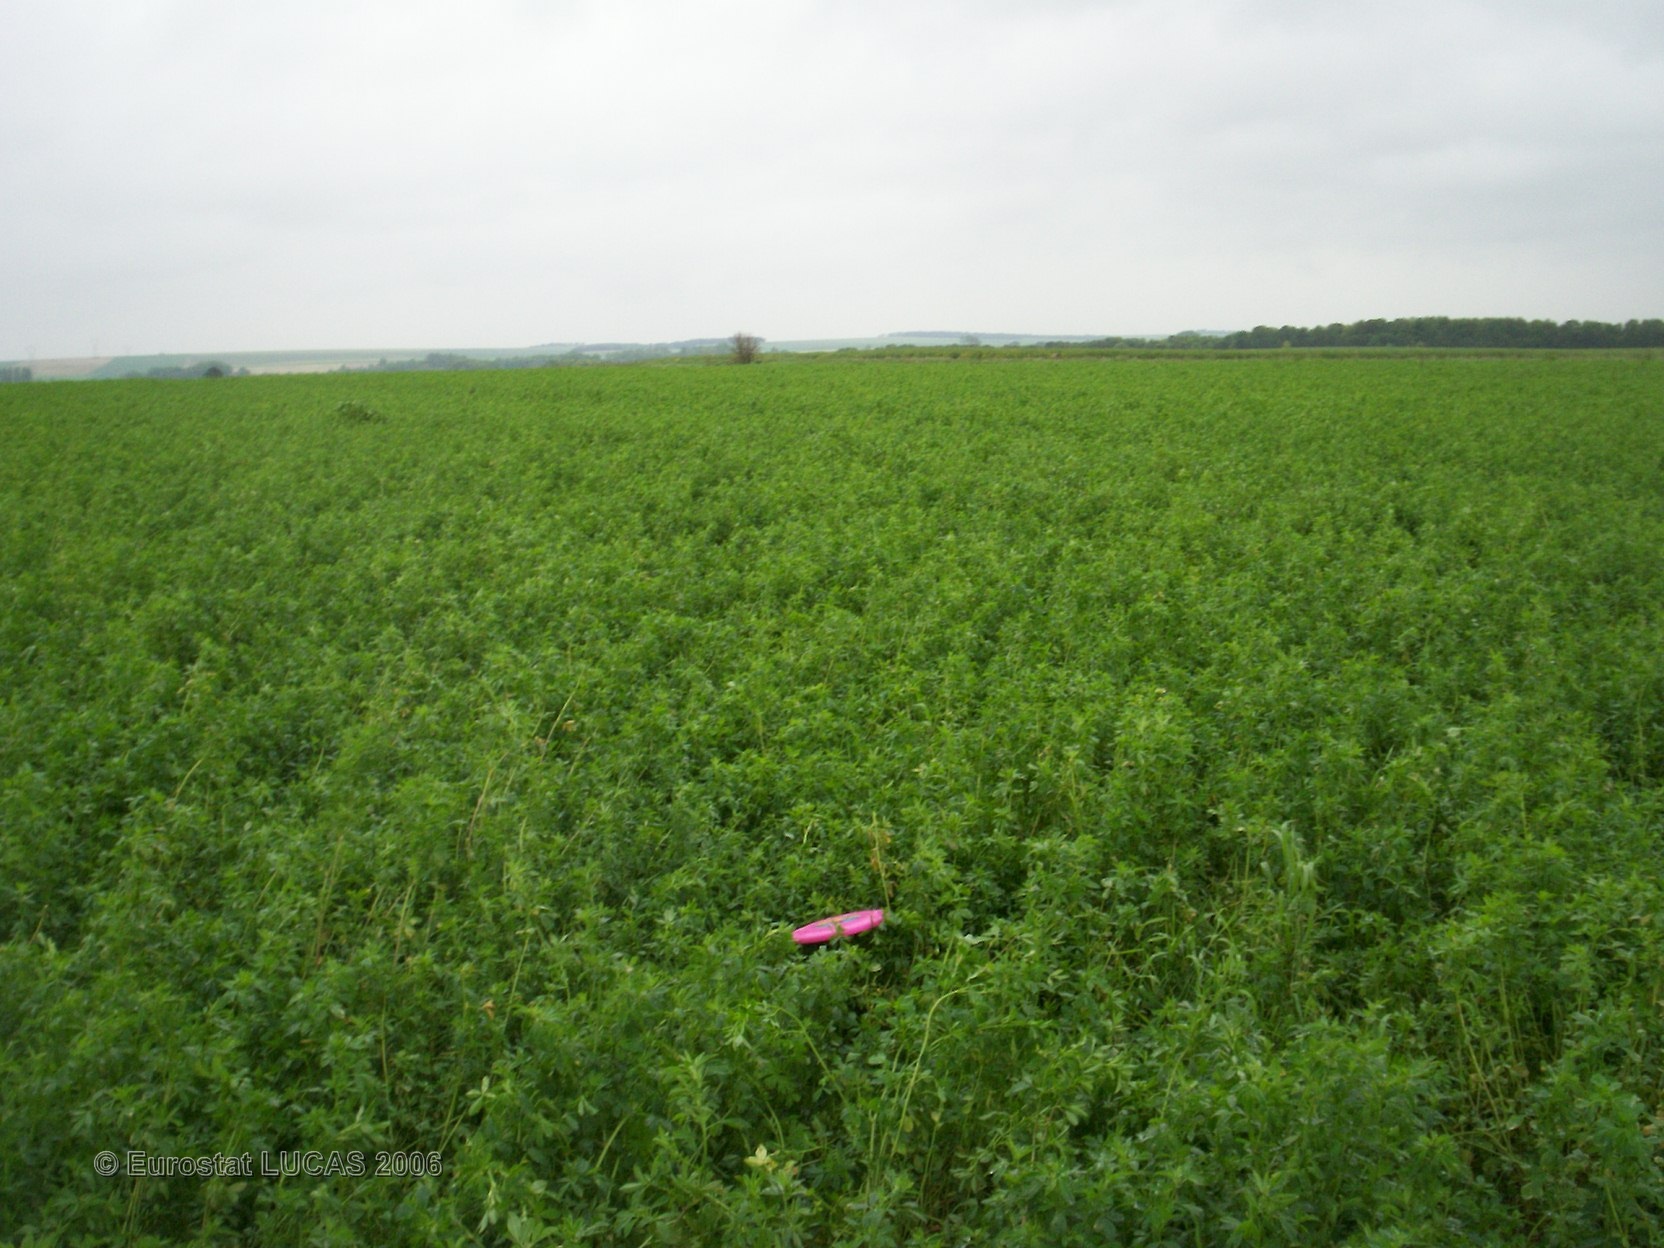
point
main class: Cropland
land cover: Lucerne
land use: Agriculture (excluding fallow land and kitchen gardens)
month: May
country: FR
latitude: 49.3805
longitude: 4.4175
